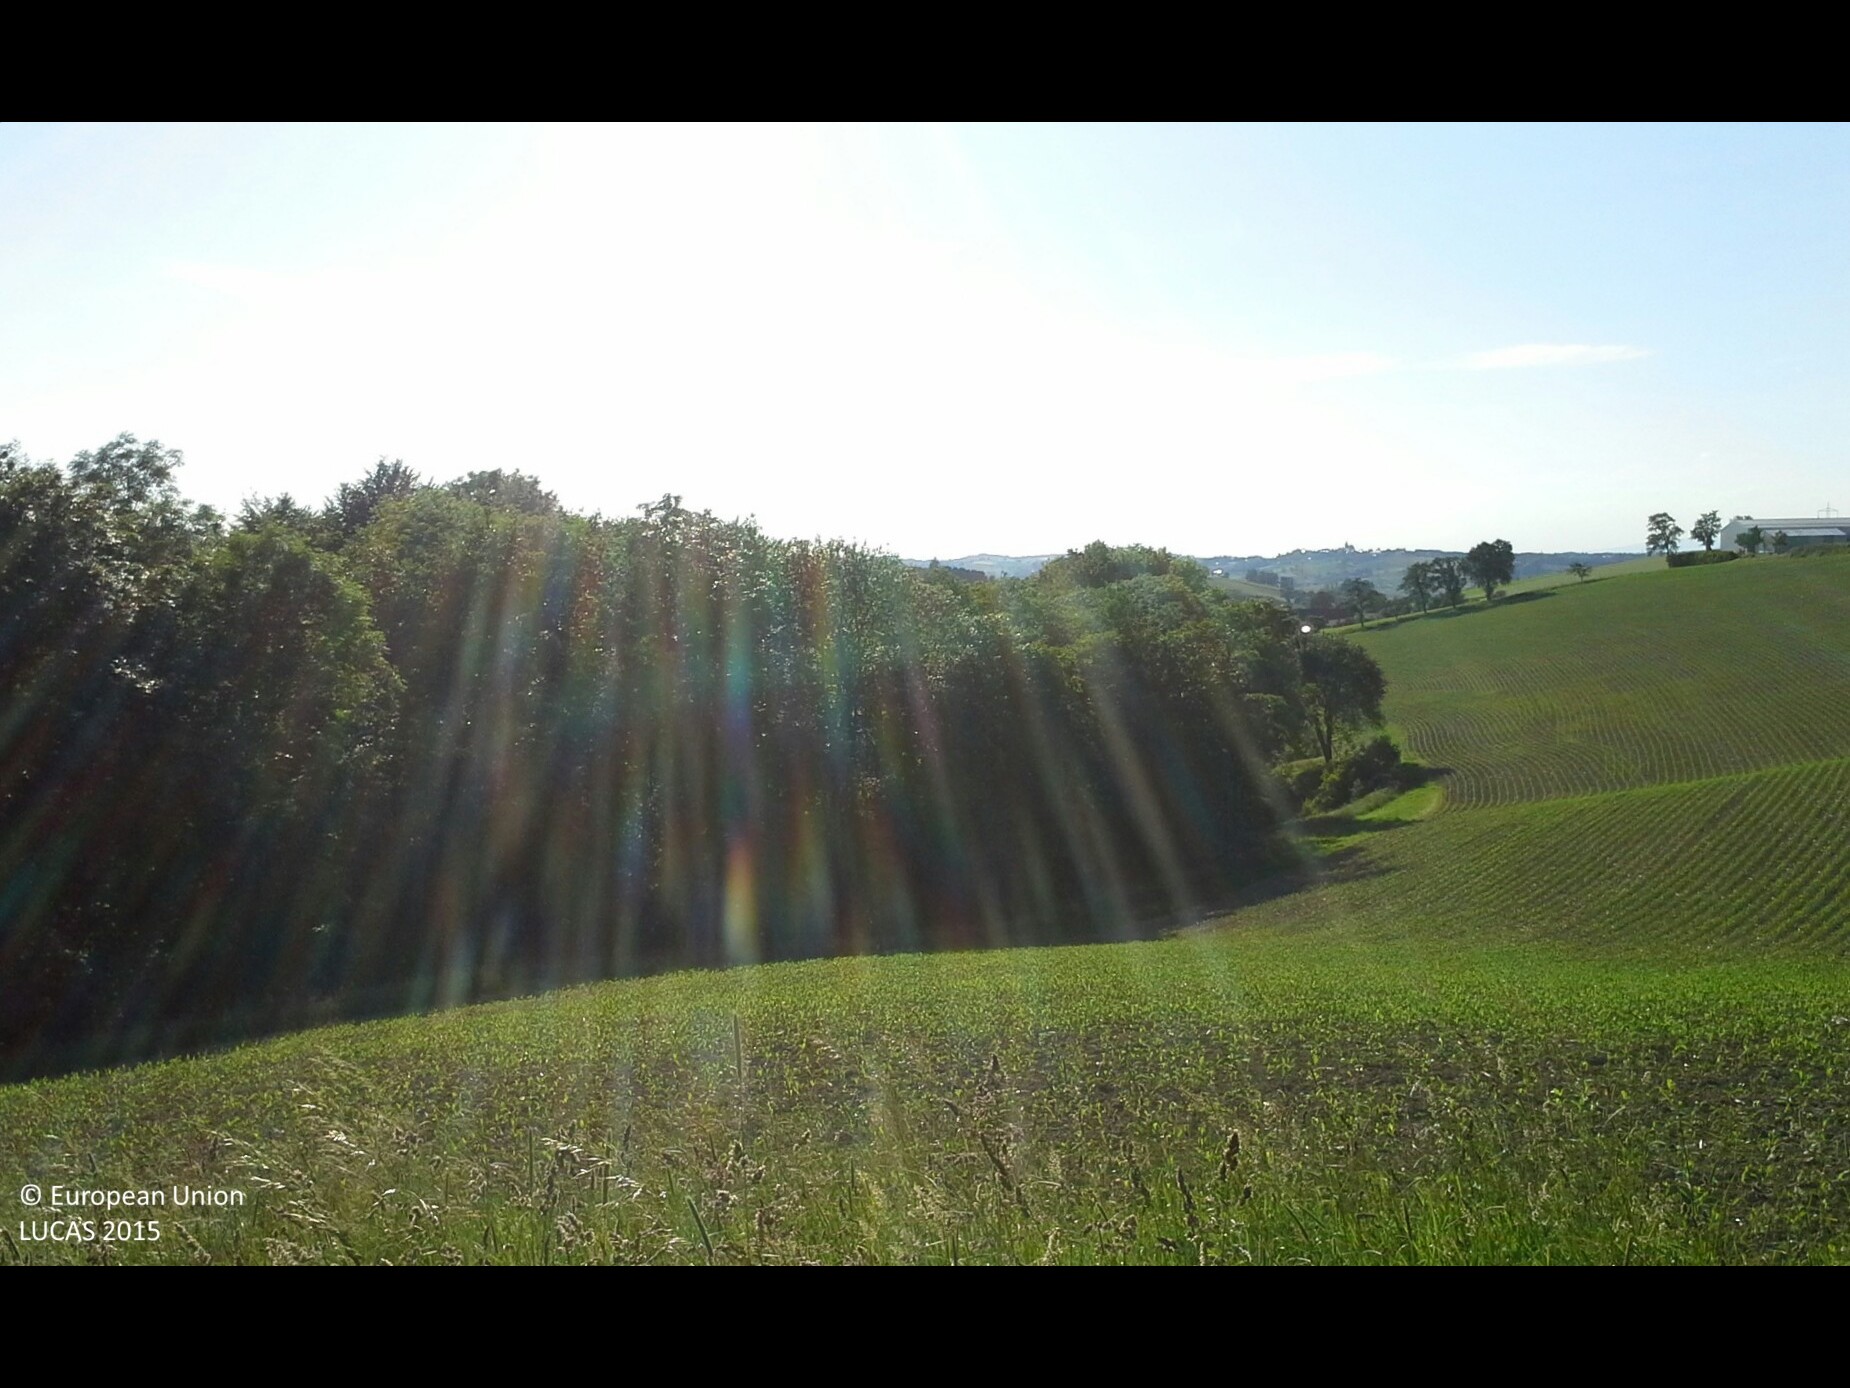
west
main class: Cropland
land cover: Common wheat
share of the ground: > 75 %
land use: Agriculture (excluding fallow land and kitchen gardens)
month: June
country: AT
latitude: 48.1227
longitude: 14.7160
